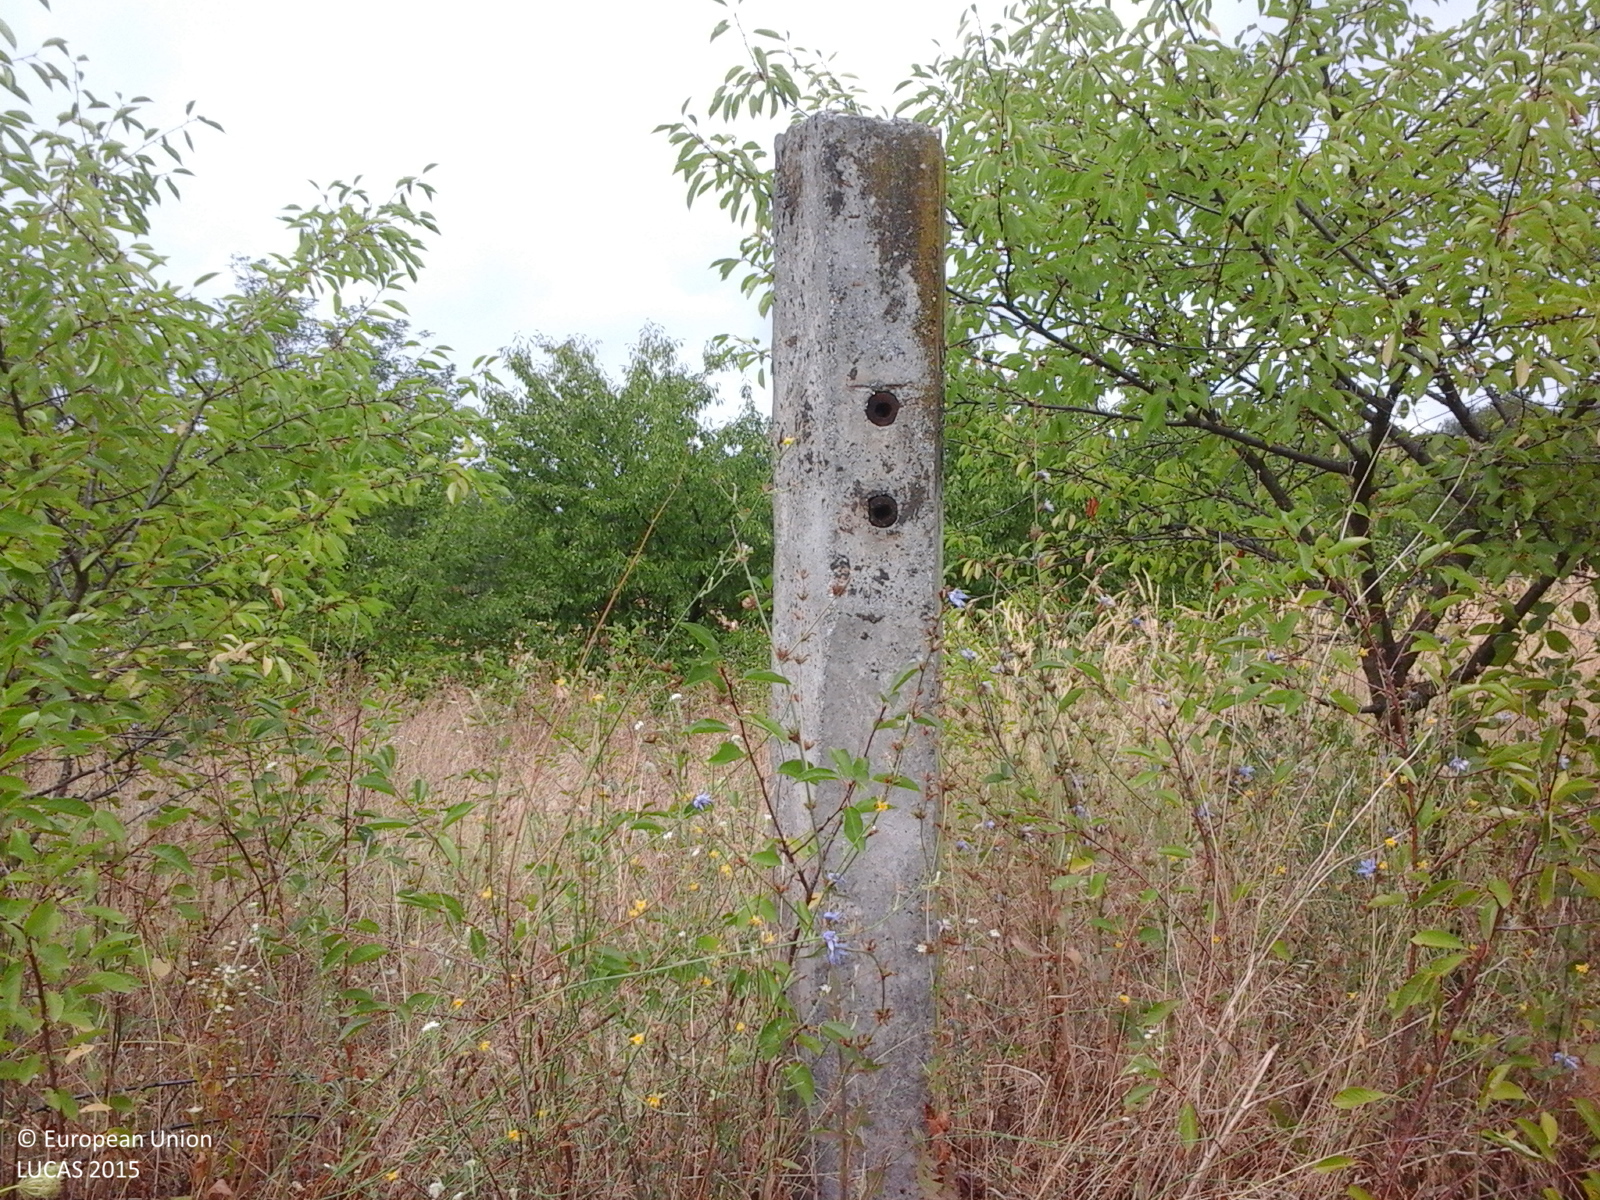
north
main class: Cropland
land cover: Lucerne
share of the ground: > 75 %
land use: Agriculture (excluding fallow land and kitchen gardens)
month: August
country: RO
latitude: 44.6412
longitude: 22.7128
